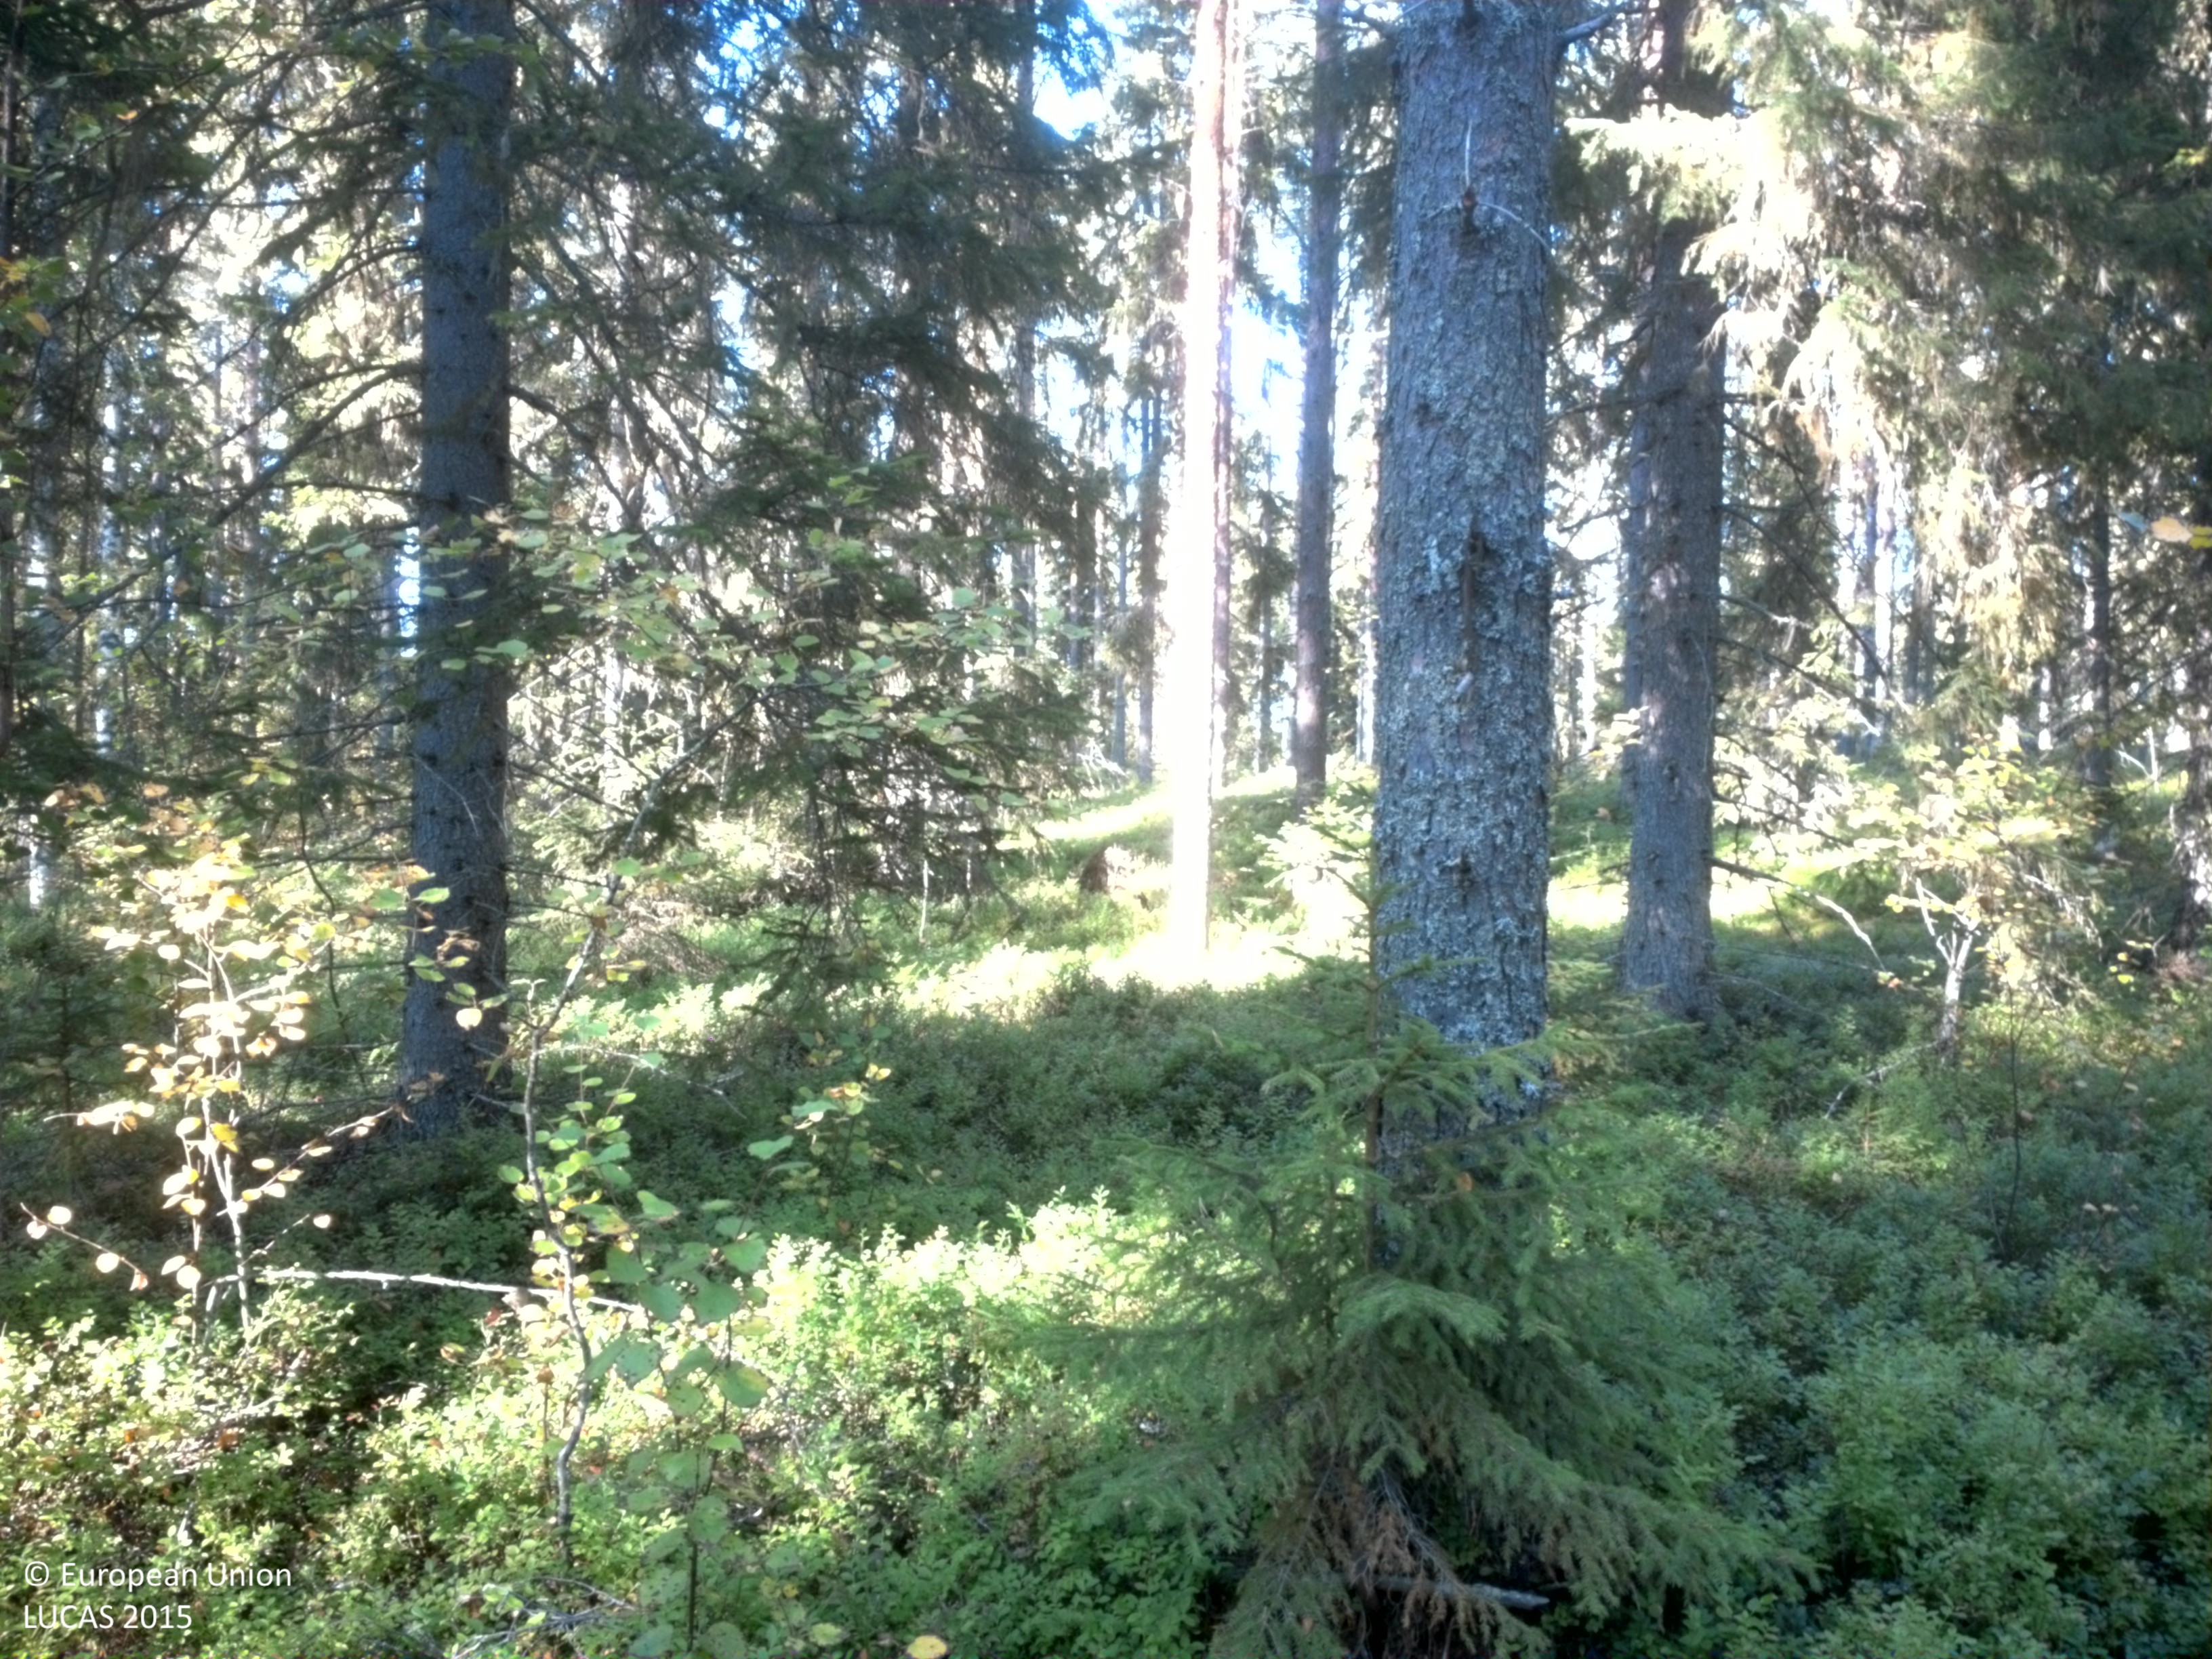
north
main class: Woodland
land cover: Other mixed woodland
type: boreal forest
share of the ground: 50 - 75 %
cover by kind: coniferous forest trees 40 %, shrubs 40 %, broadleaved forest trees 20 %
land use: Forestry
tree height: > 5 m
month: September
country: SE
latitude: 64.3184
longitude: 19.7152
